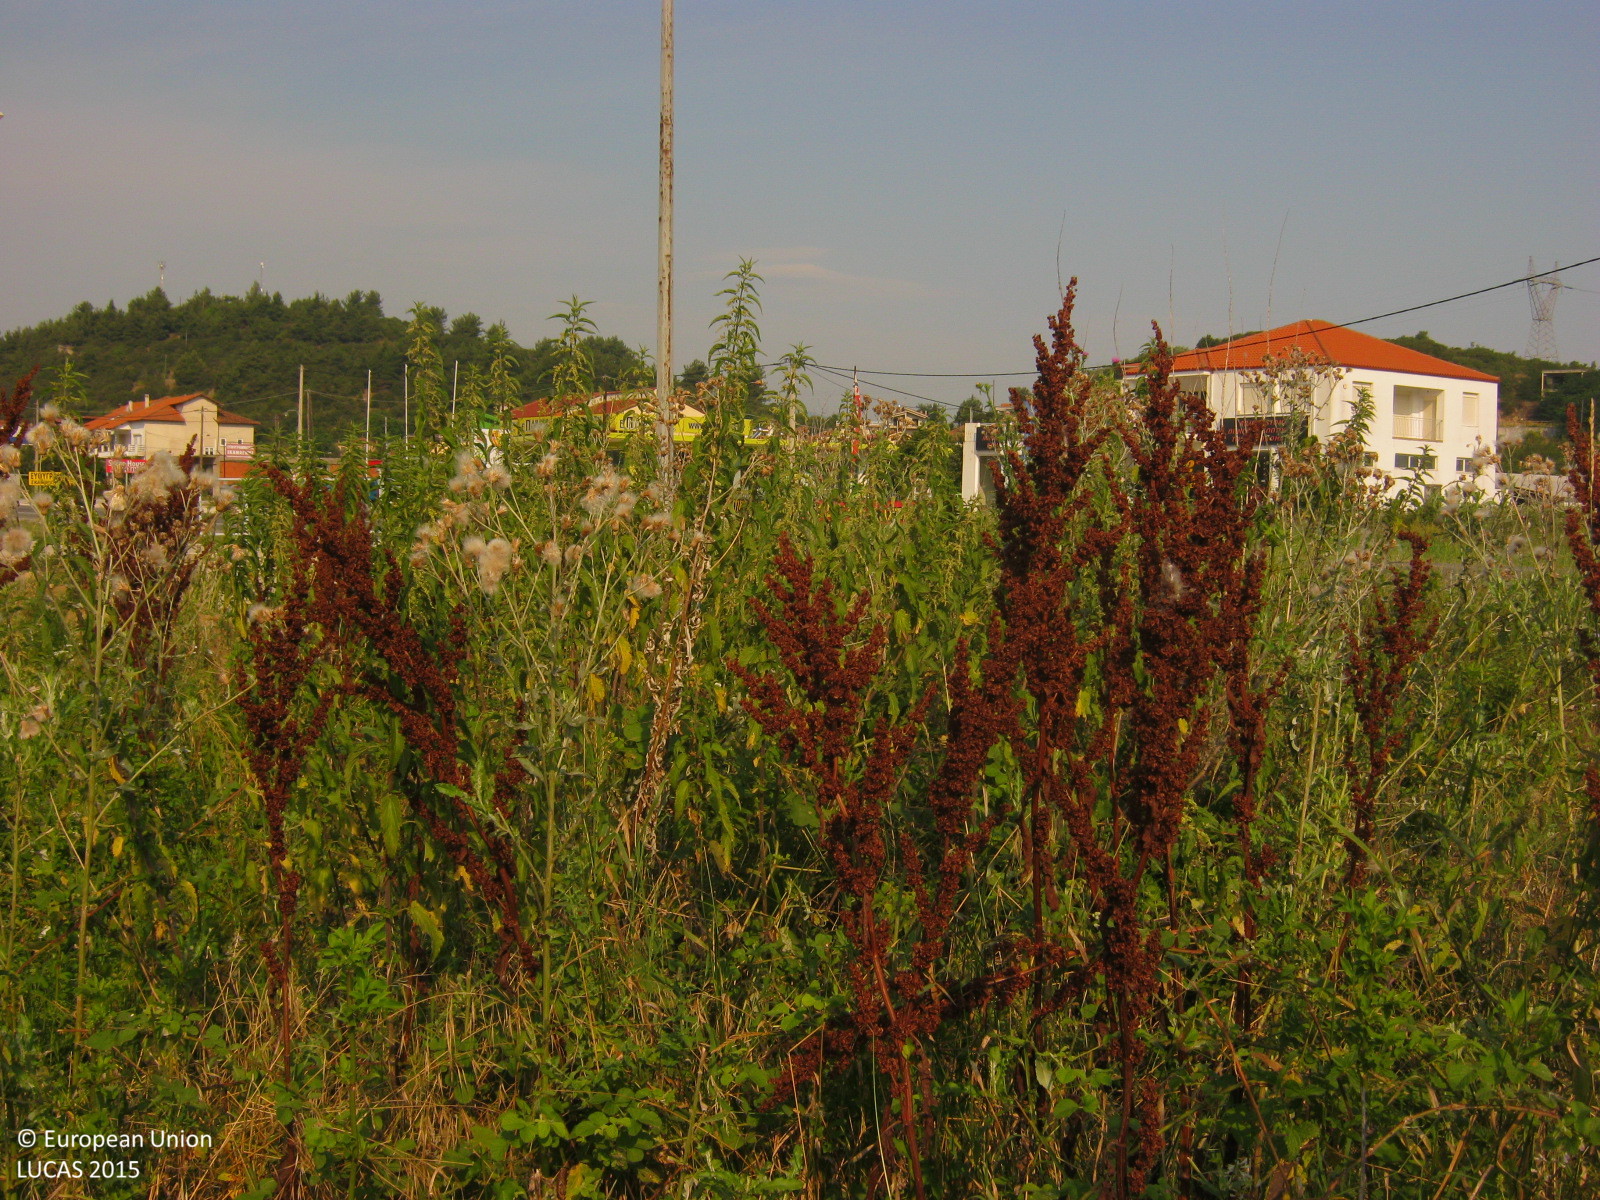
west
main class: Grassland
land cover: Spontaneously vegetated surfaces
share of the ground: > 75 %
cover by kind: herbaceous plants 100 %
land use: Fallow land
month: July
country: GR
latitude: 40.9348
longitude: 24.3172
